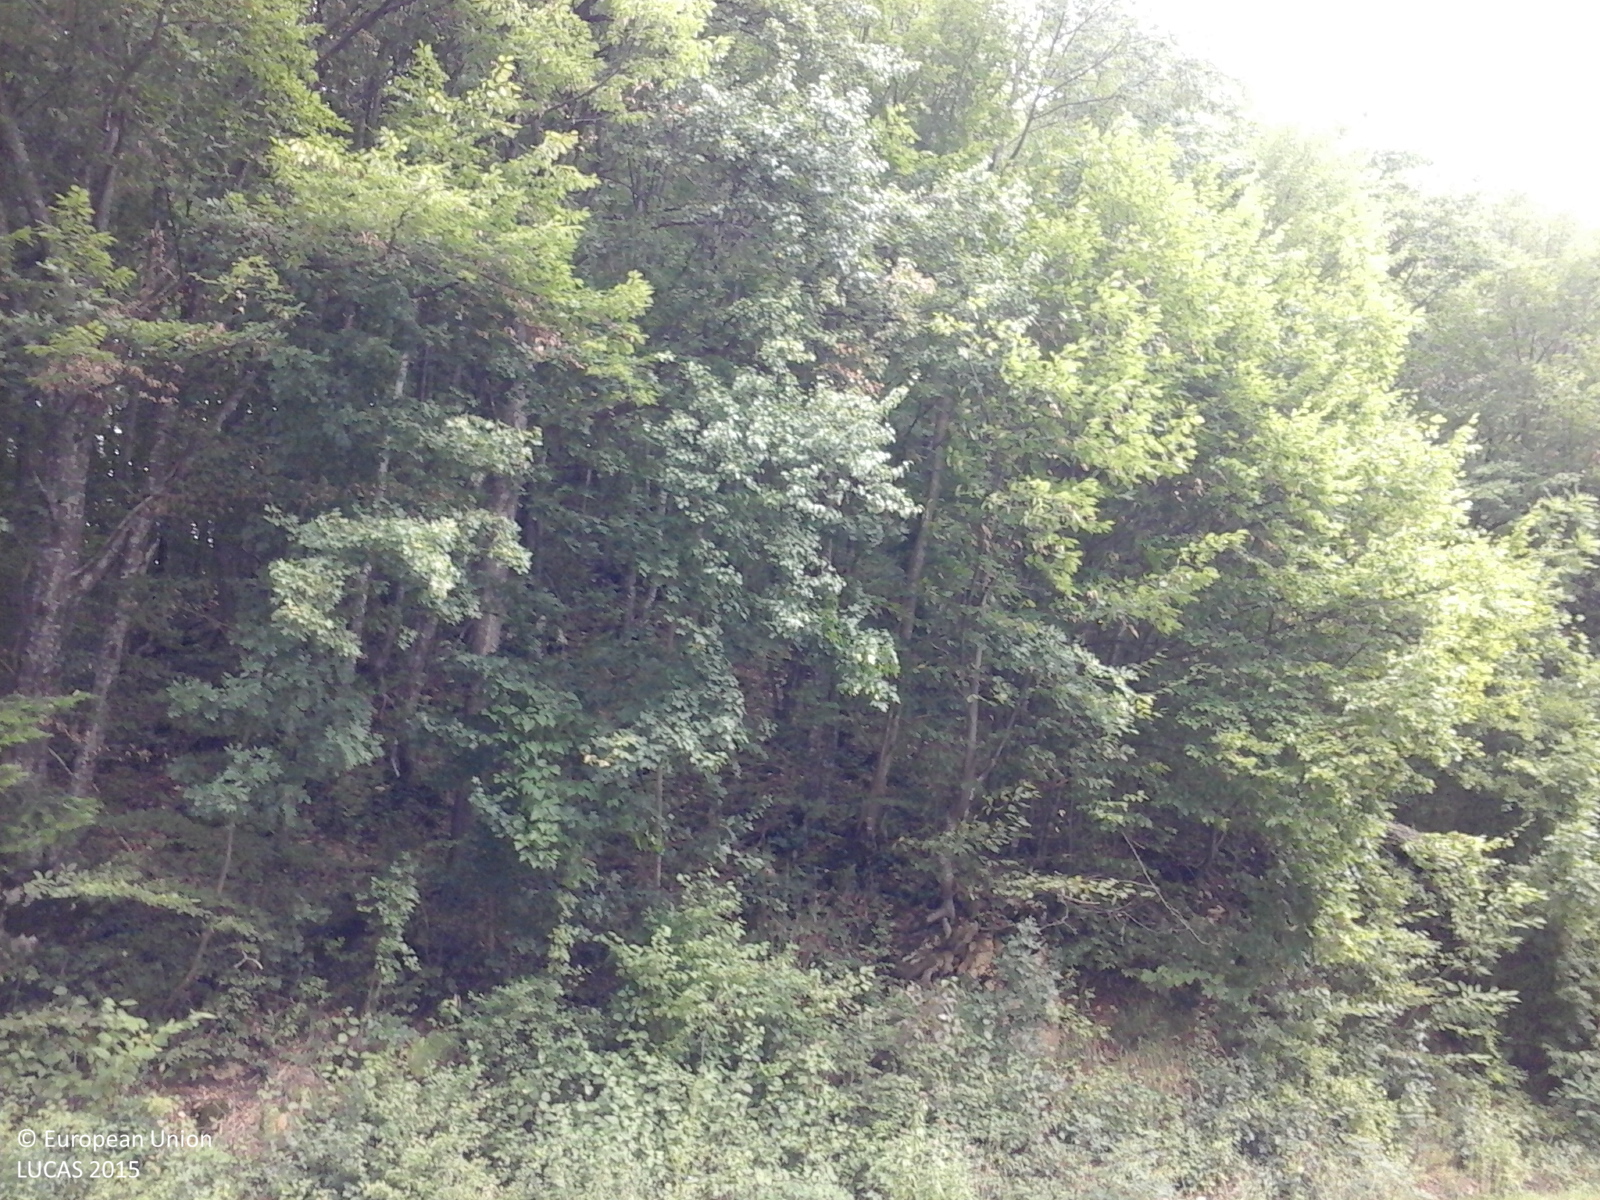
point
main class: Woodland
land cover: Broadleaved woodland
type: acidophilous oak and oak-birch forest
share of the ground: > 75 %
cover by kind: broadleaved forest trees 100 %
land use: Forestry
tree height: > 5 m
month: August
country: RO
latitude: 45.0317
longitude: 21.8763
